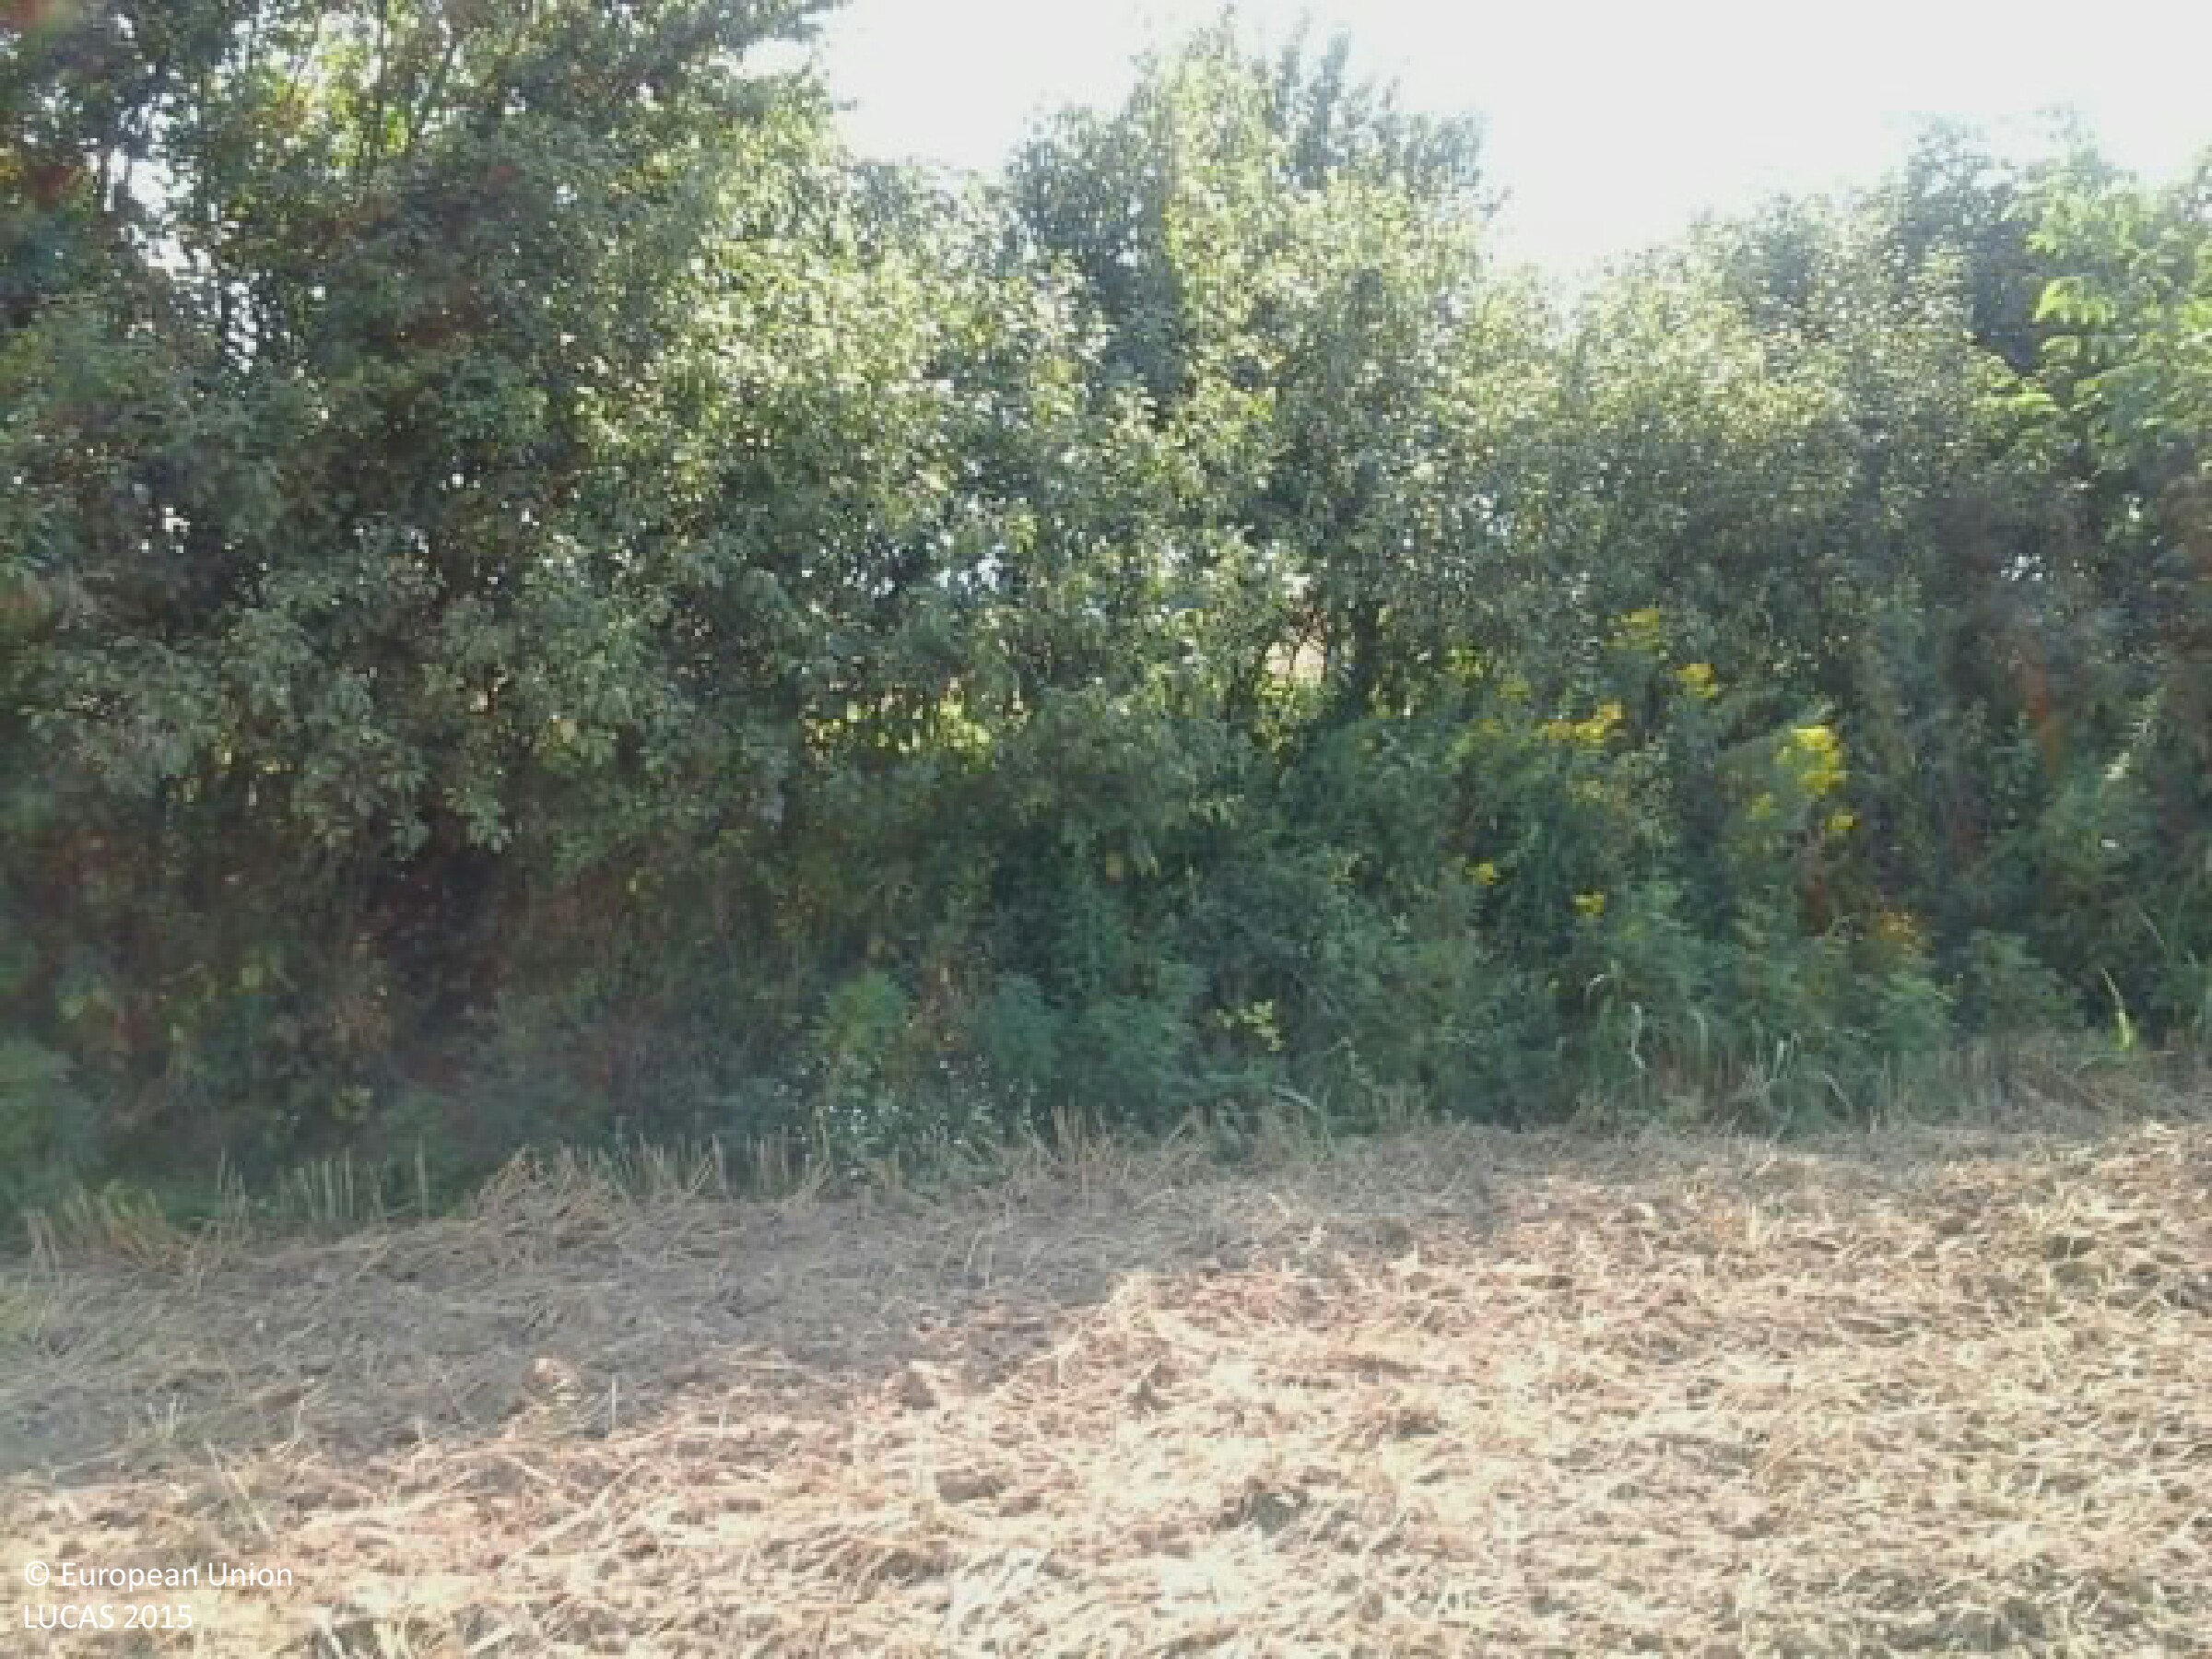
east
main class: Cropland
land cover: Common wheat
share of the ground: < 10 %
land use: Agriculture (excluding fallow land and kitchen gardens)
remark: Harvested field
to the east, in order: Common wheat; Shrubland with sparse tree cover; Common wheat; Lines of trees; Maize
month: August
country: HU
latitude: 46.5116
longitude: 17.8919
